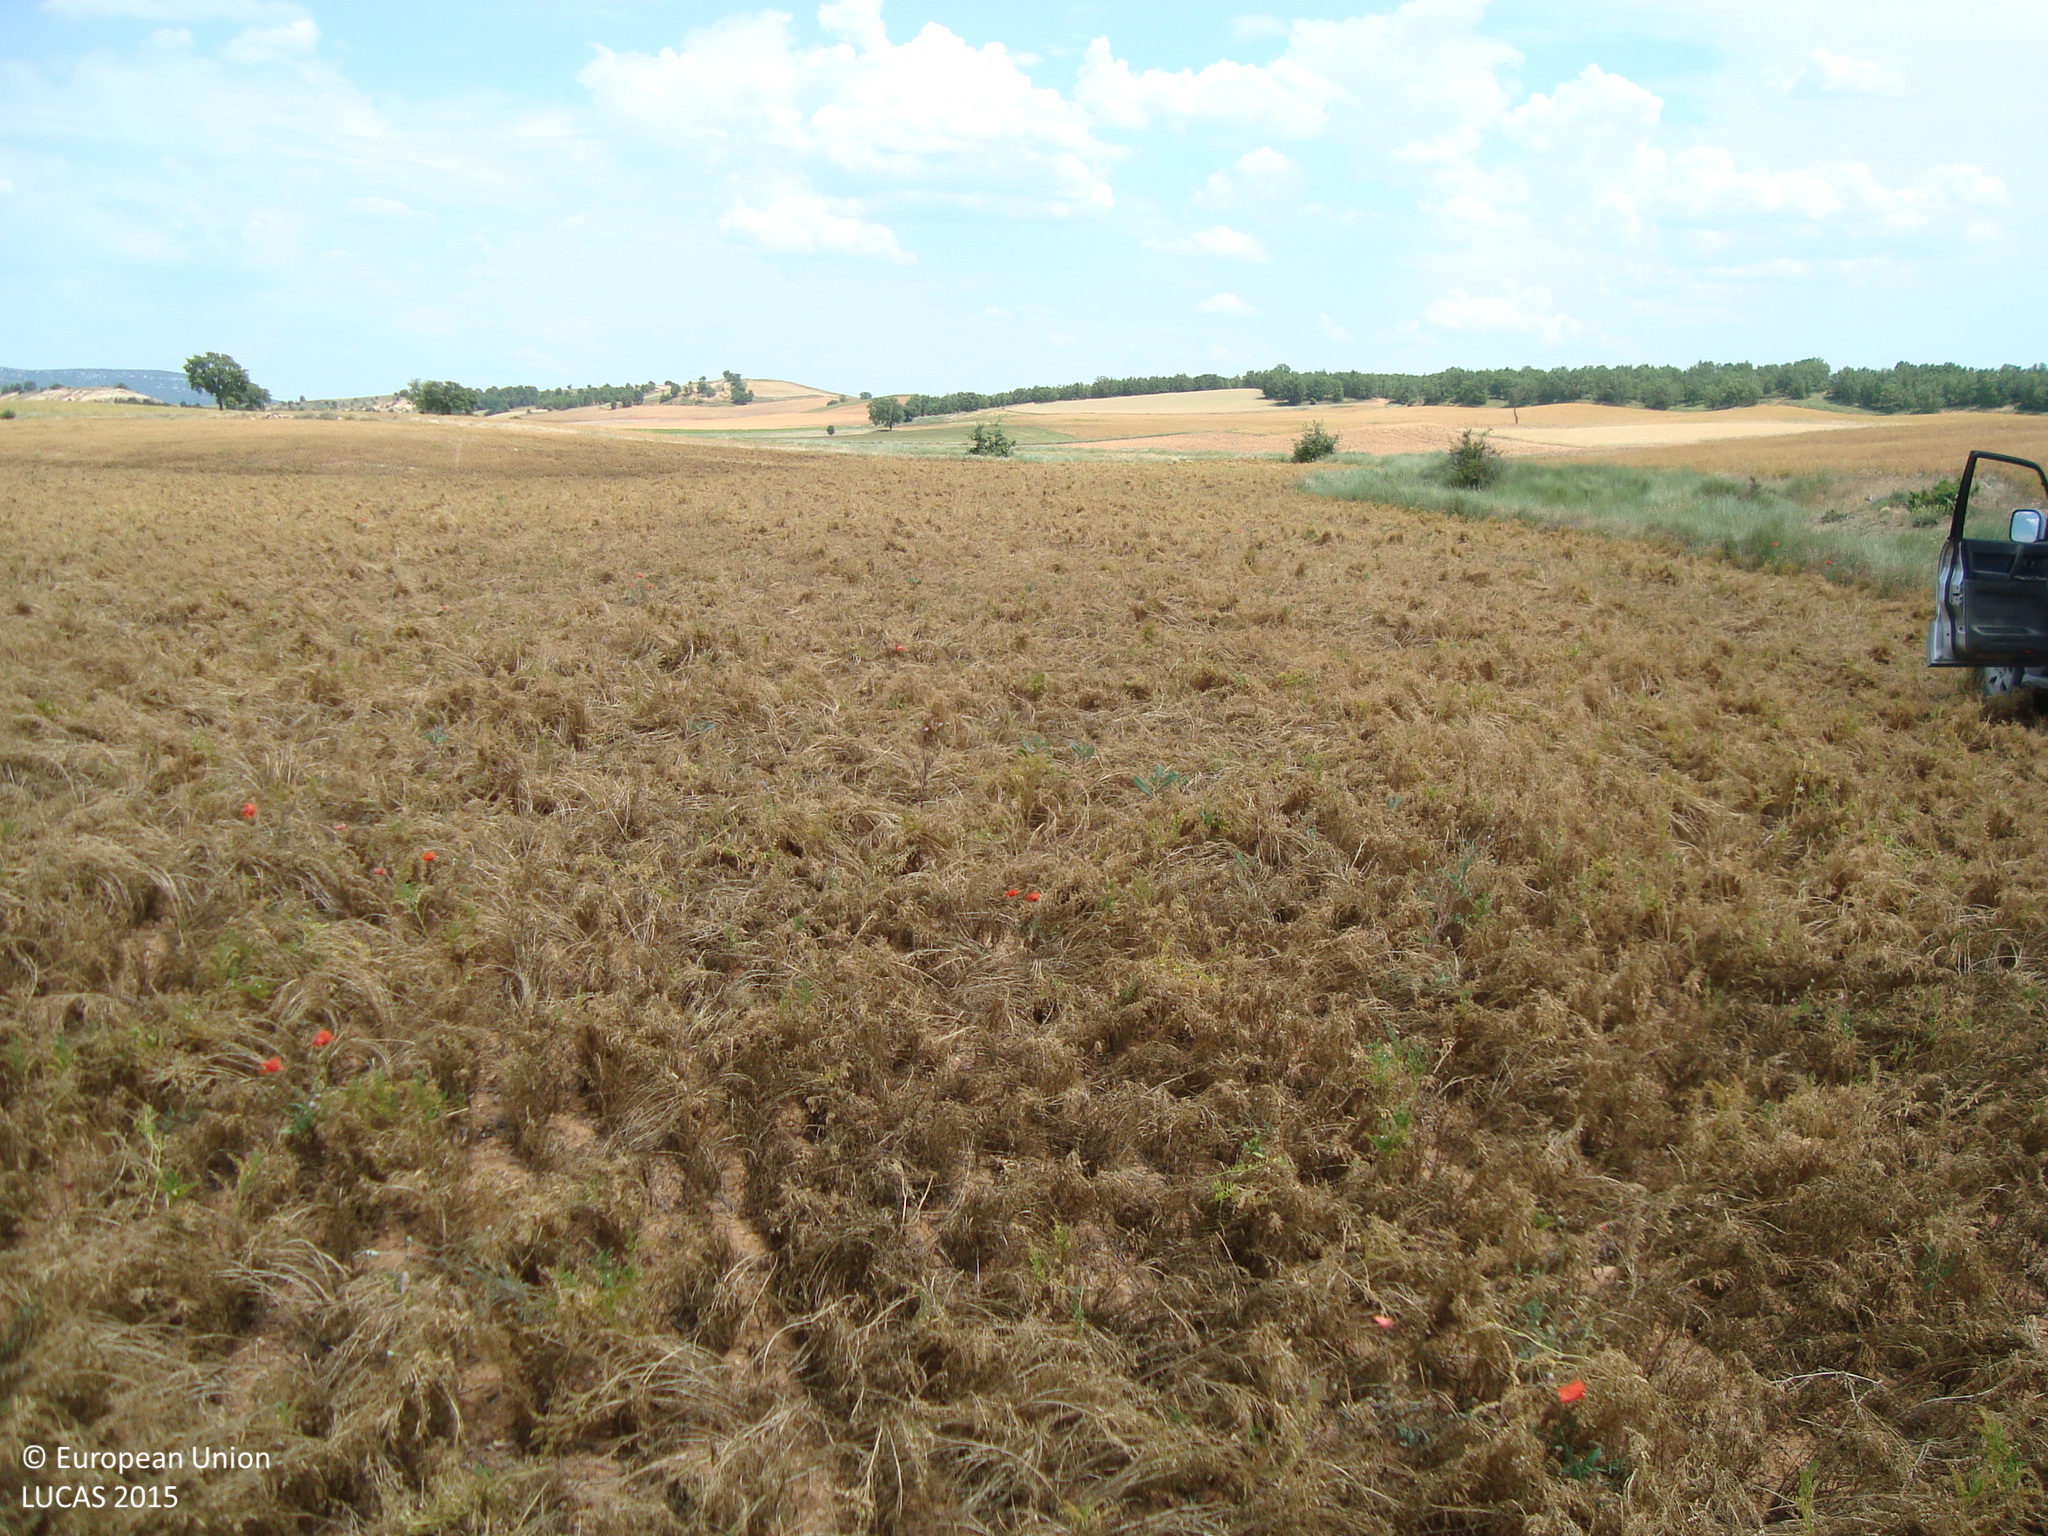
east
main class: Cropland
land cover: Dry pulses
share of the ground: > 75 %
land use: Agriculture (excluding fallow land and kitchen gardens)
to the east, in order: Dry pulses; Tracks; Dry pulses; Rivers and streams; Other bare soil
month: June
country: ES
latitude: 41.8834
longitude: -3.5623
